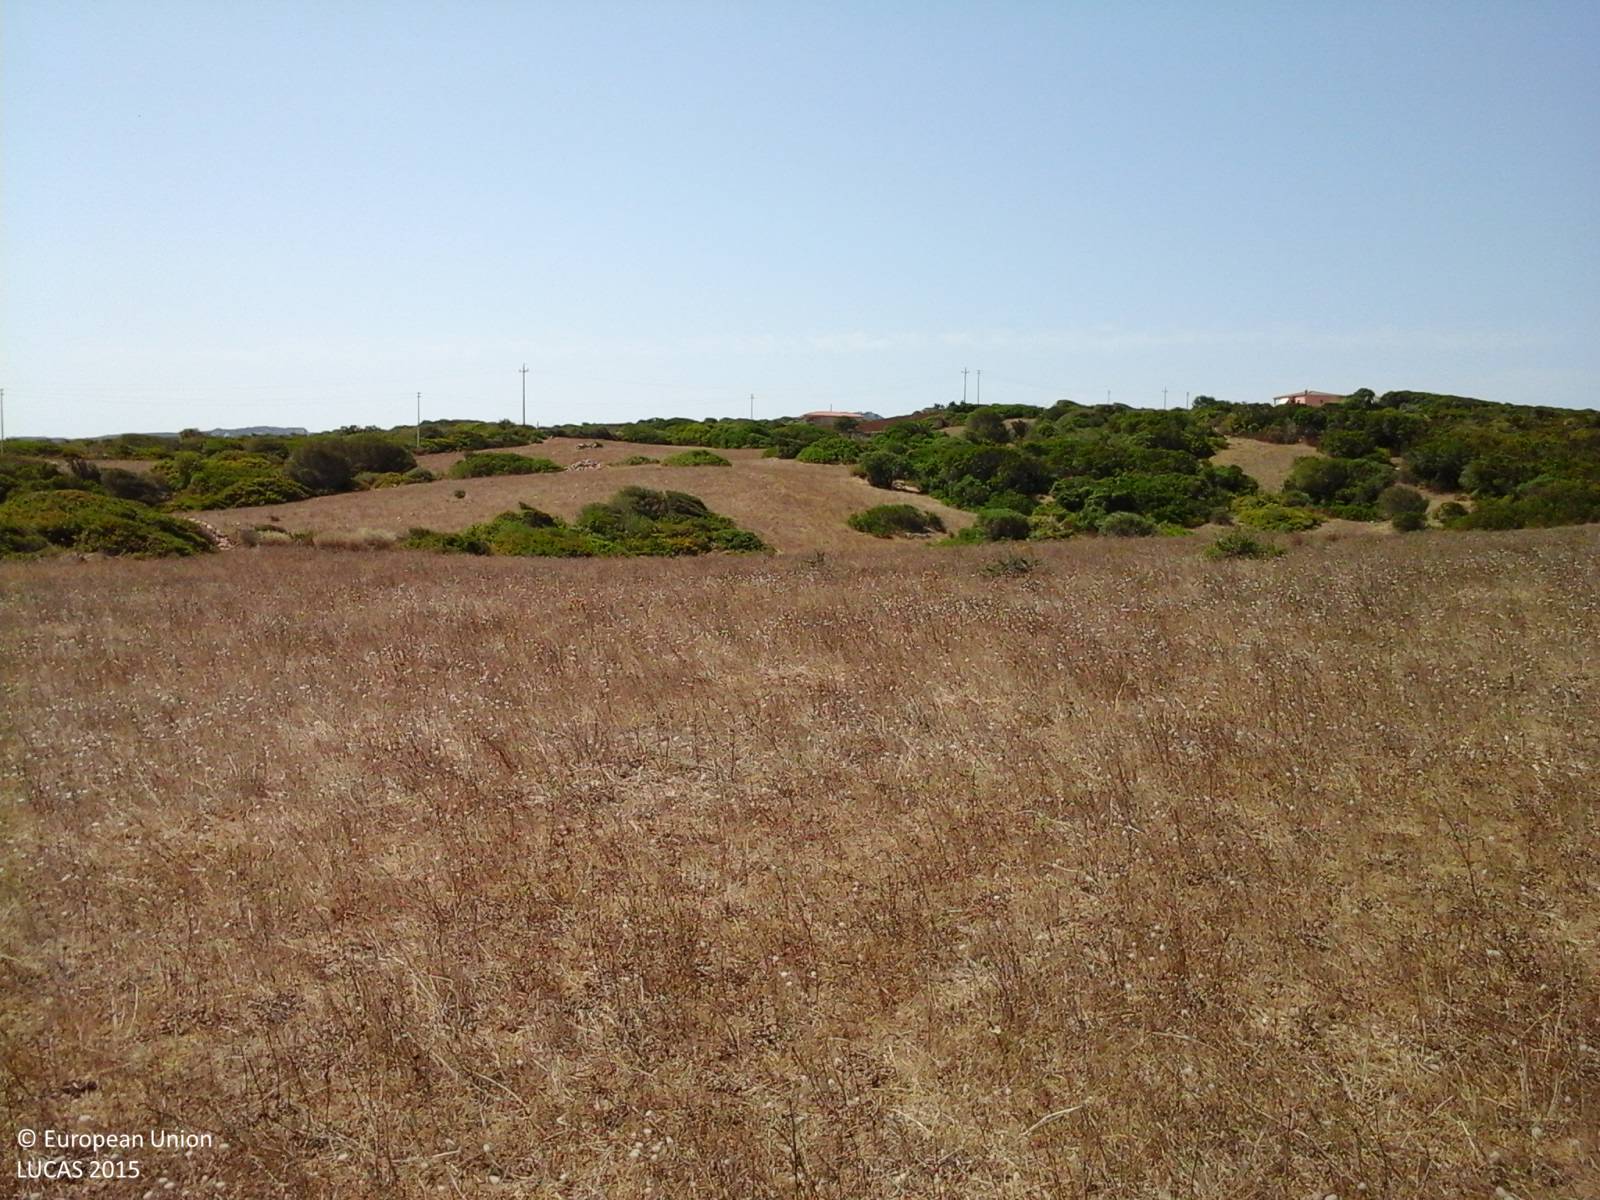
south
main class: Grassland
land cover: Grassland without tree/shrub cover
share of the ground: 50 - 75 %
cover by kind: herbaceous plants 100 %
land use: Agriculture (excluding fallow land and kitchen gardens)
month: July
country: IT
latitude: 41.2054
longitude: 9.2520
